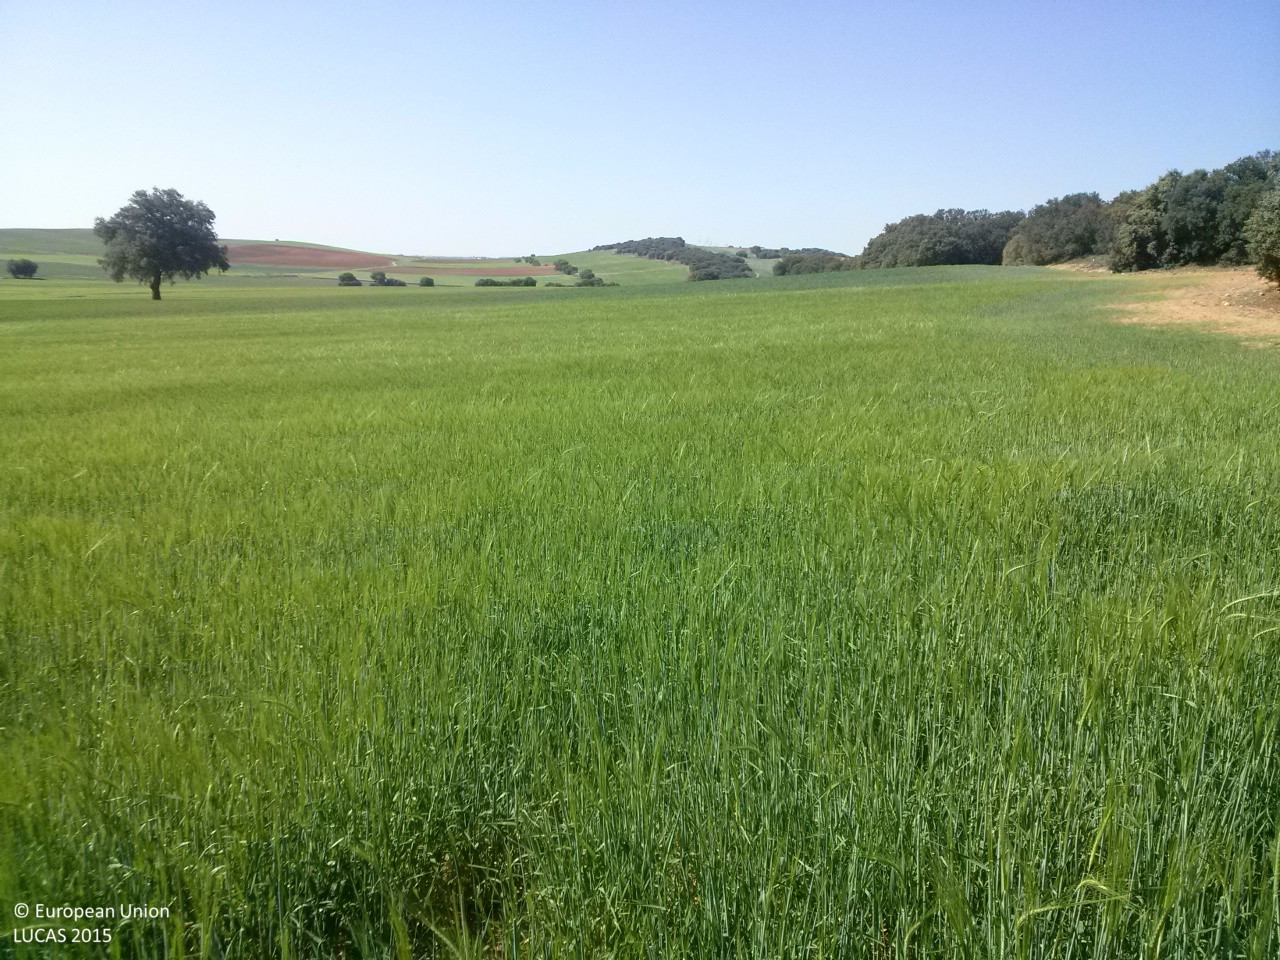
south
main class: Cropland
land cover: Barley
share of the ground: > 75 %
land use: Agriculture (excluding fallow land and kitchen gardens)
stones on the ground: 10 - 25 %
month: May
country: ES
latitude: 39.8616
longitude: -2.8201
